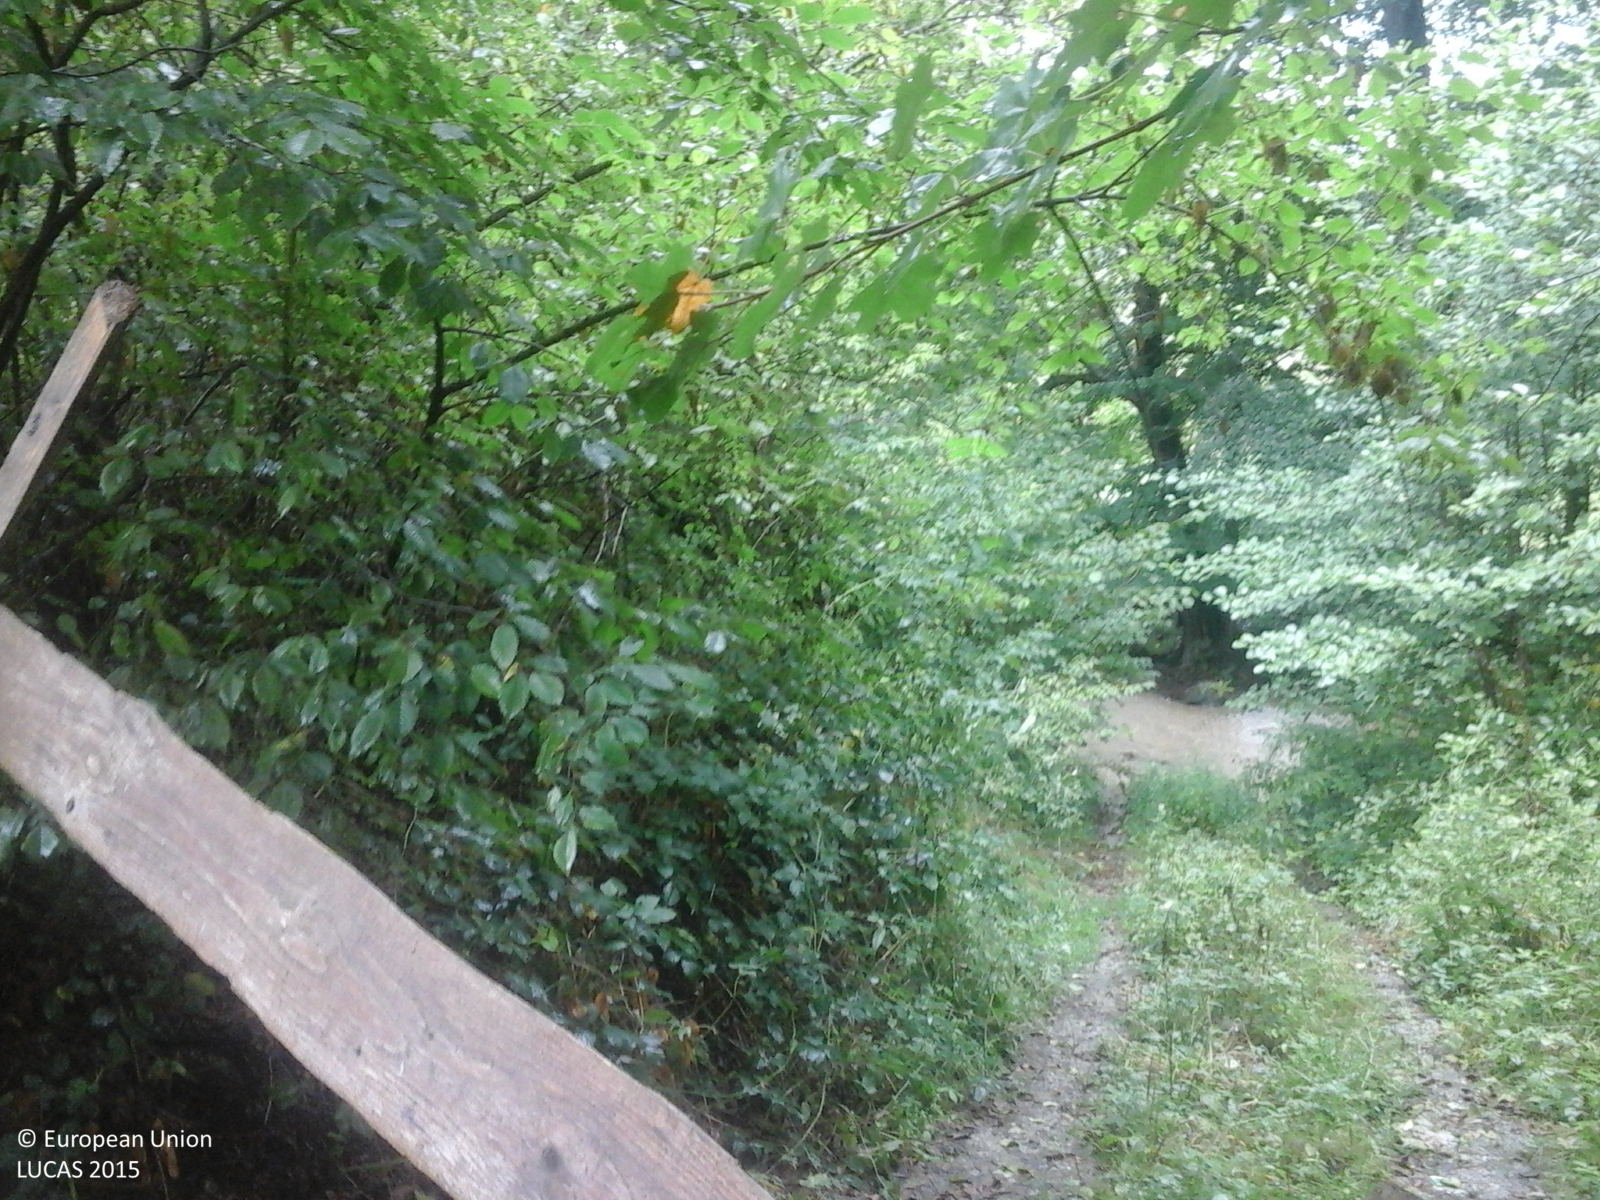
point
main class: Woodland
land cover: Broadleaved woodland
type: mesophytic deciduous forest
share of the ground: > 75 %
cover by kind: broadleaved forest trees 100 %
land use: Forestry
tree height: > 5 m
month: August
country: RO
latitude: 44.9288
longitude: 22.1366
